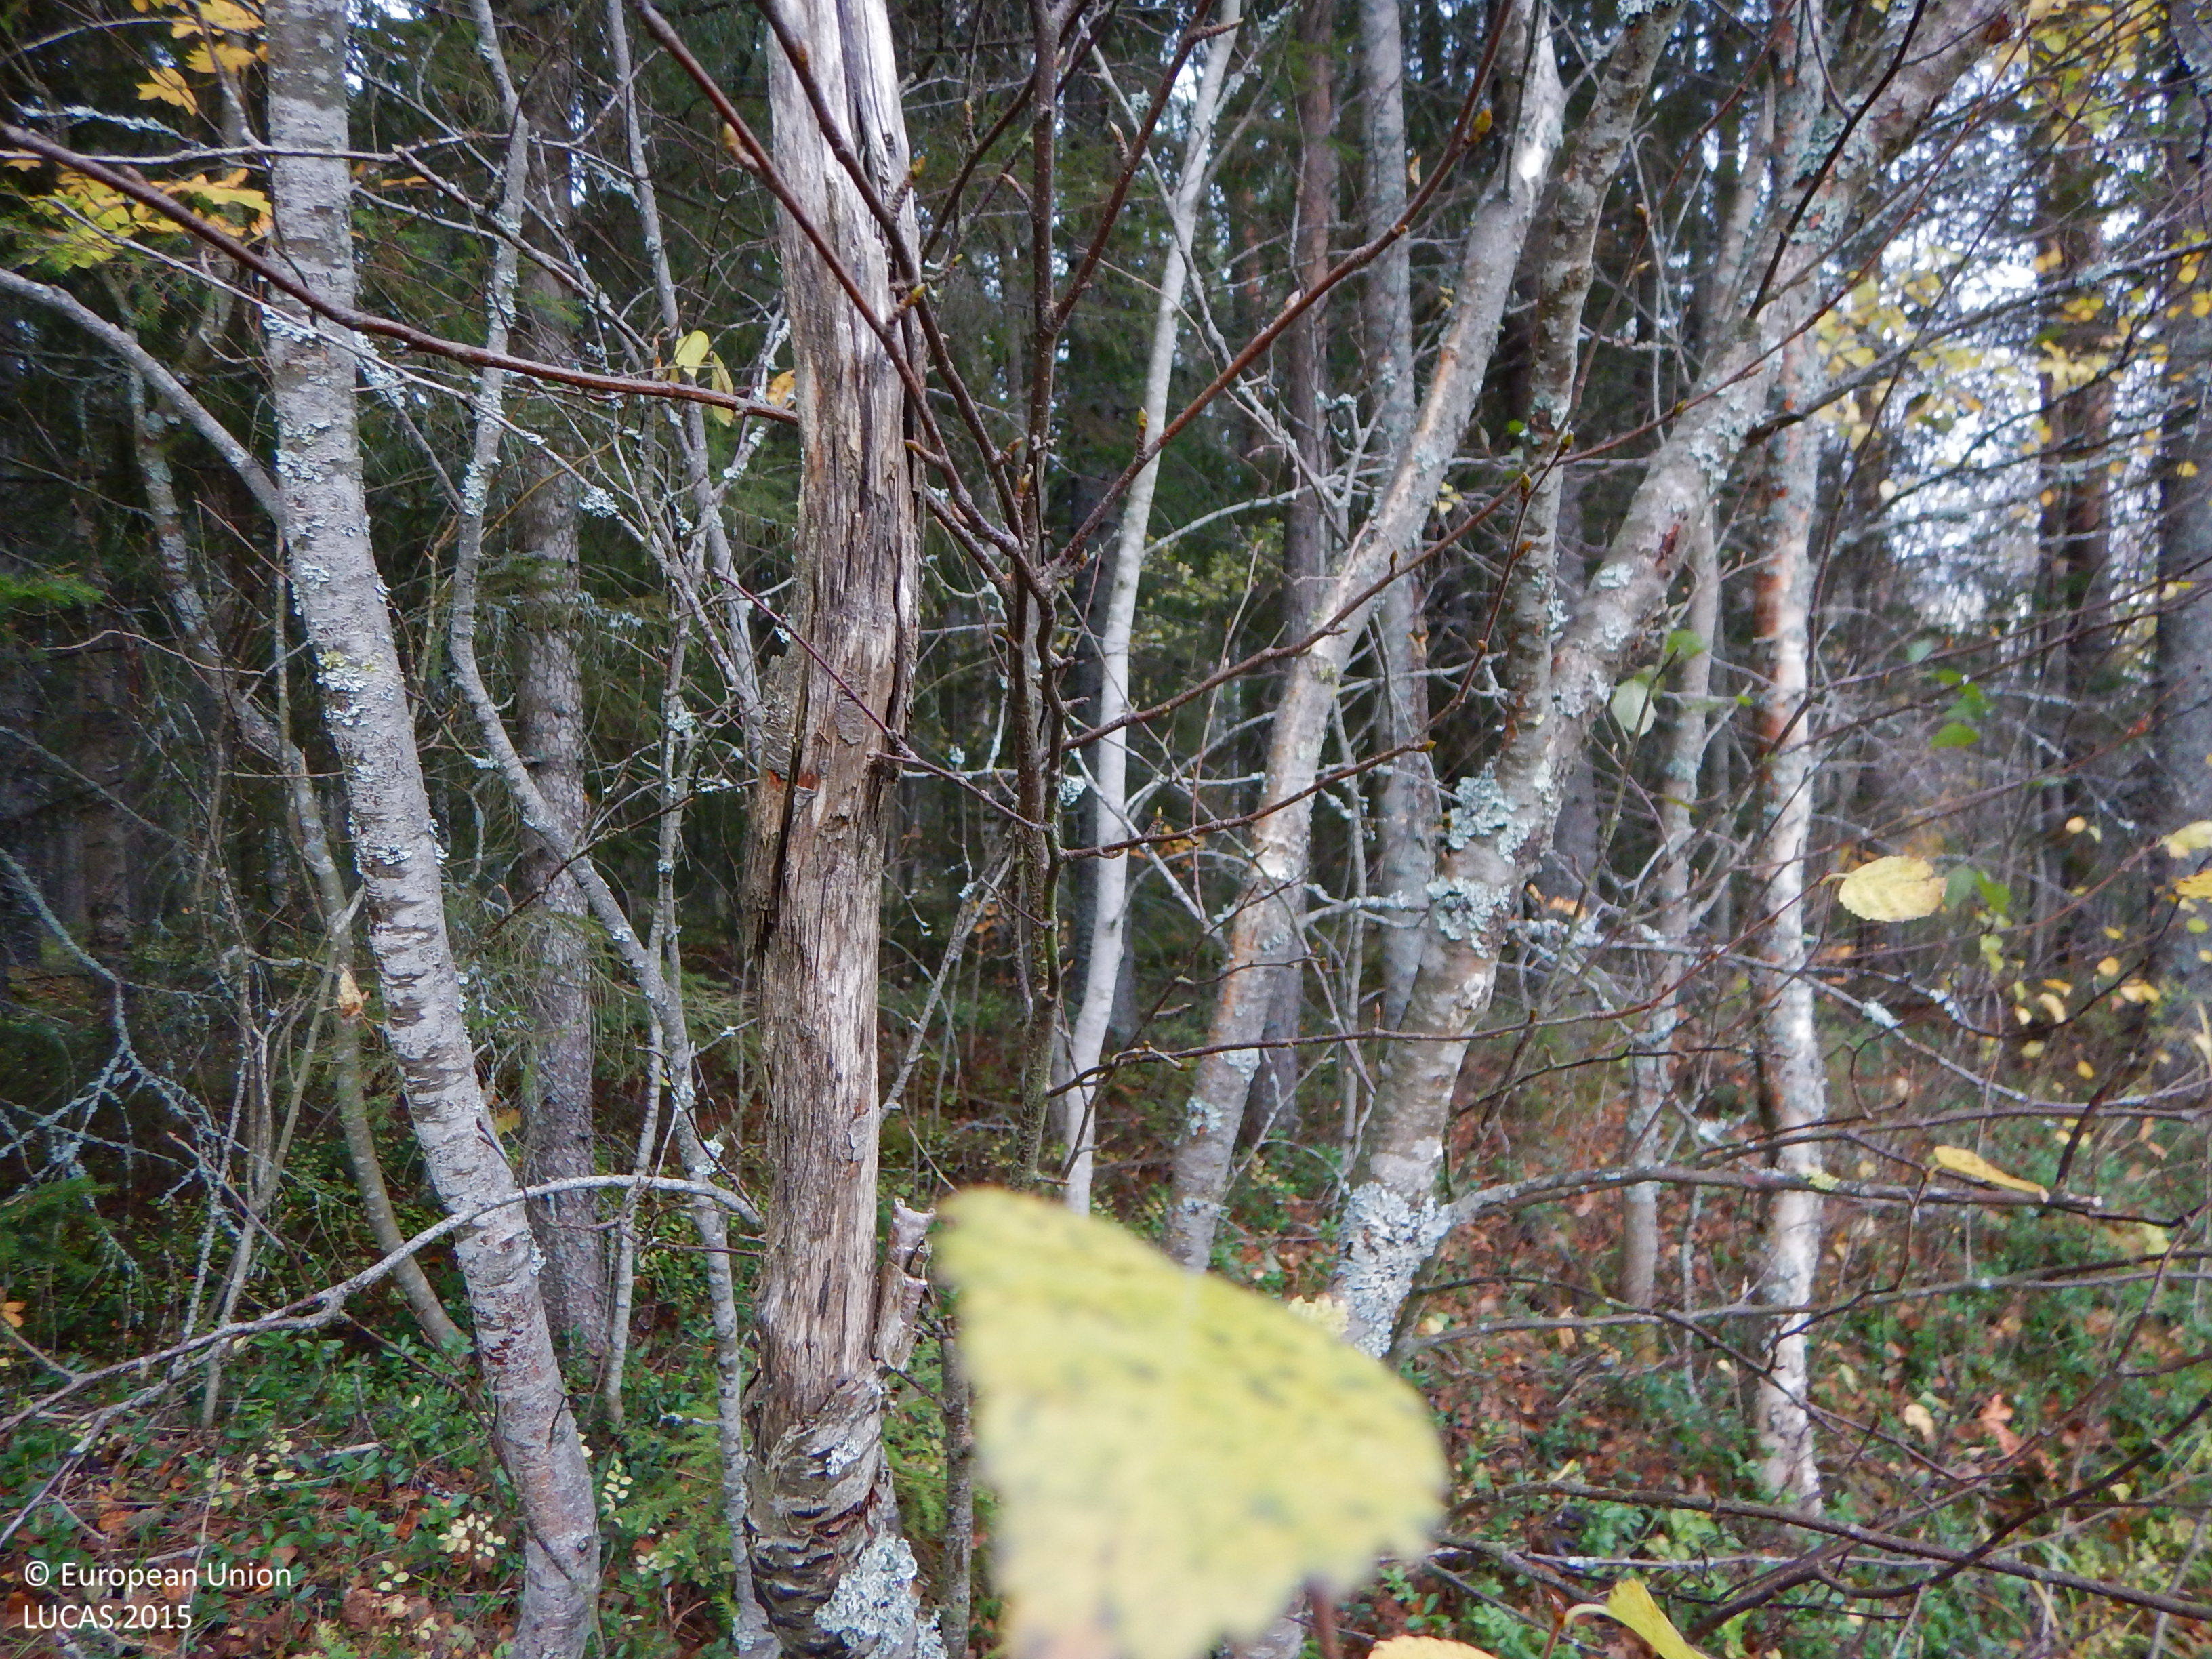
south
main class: Woodland
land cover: Spruce dominated mixed woodland
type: boreal forest
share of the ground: > 75 %
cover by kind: coniferous forest trees 60 %, broadleaved forest trees 20 %, shrubs 10 %, herbaceous plants 5 %, lichens and mosses 5 %
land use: Forestry
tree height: > 5 m
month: October
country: SE
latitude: 64.8811
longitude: 20.8915
